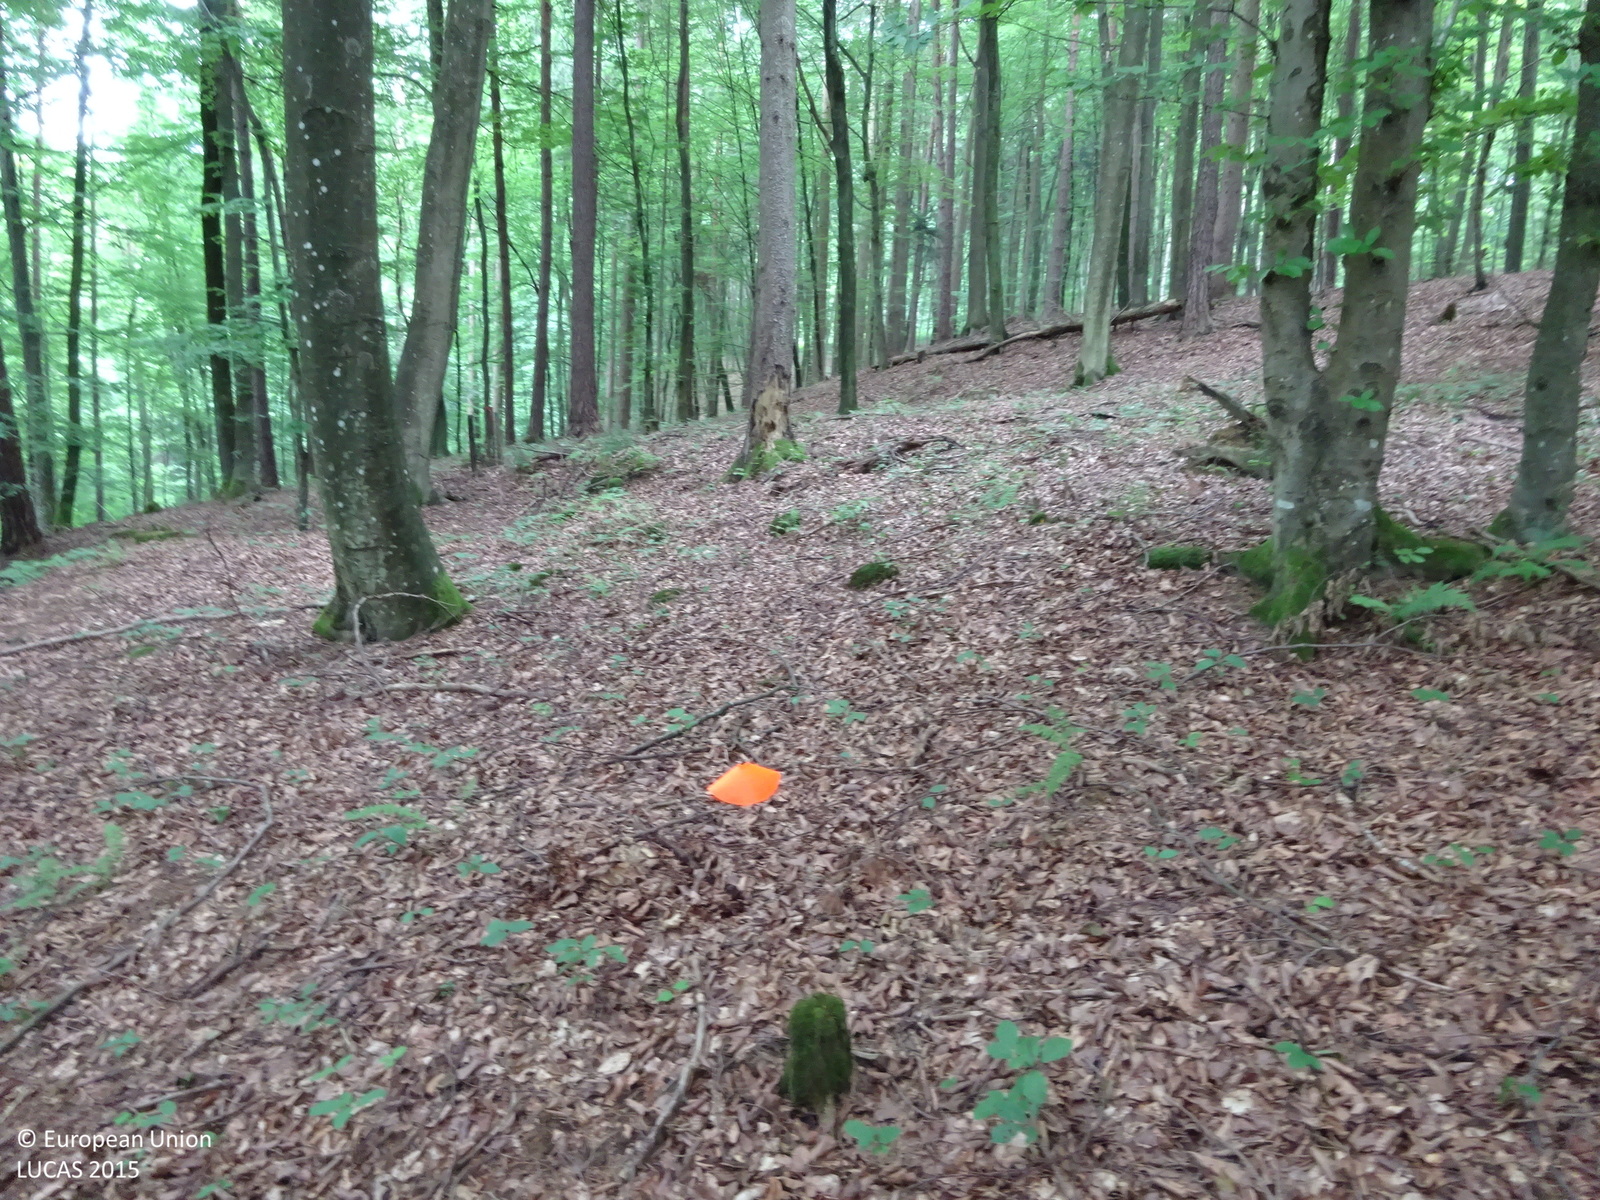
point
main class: Woodland
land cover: Broadleaved woodland
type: beech forest
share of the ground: > 75 %
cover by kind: broadleaved forest trees 80 %, coniferous forest trees 20 %
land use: Forestry
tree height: > 5 m
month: July
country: AT
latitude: 46.8098
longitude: 15.4115
